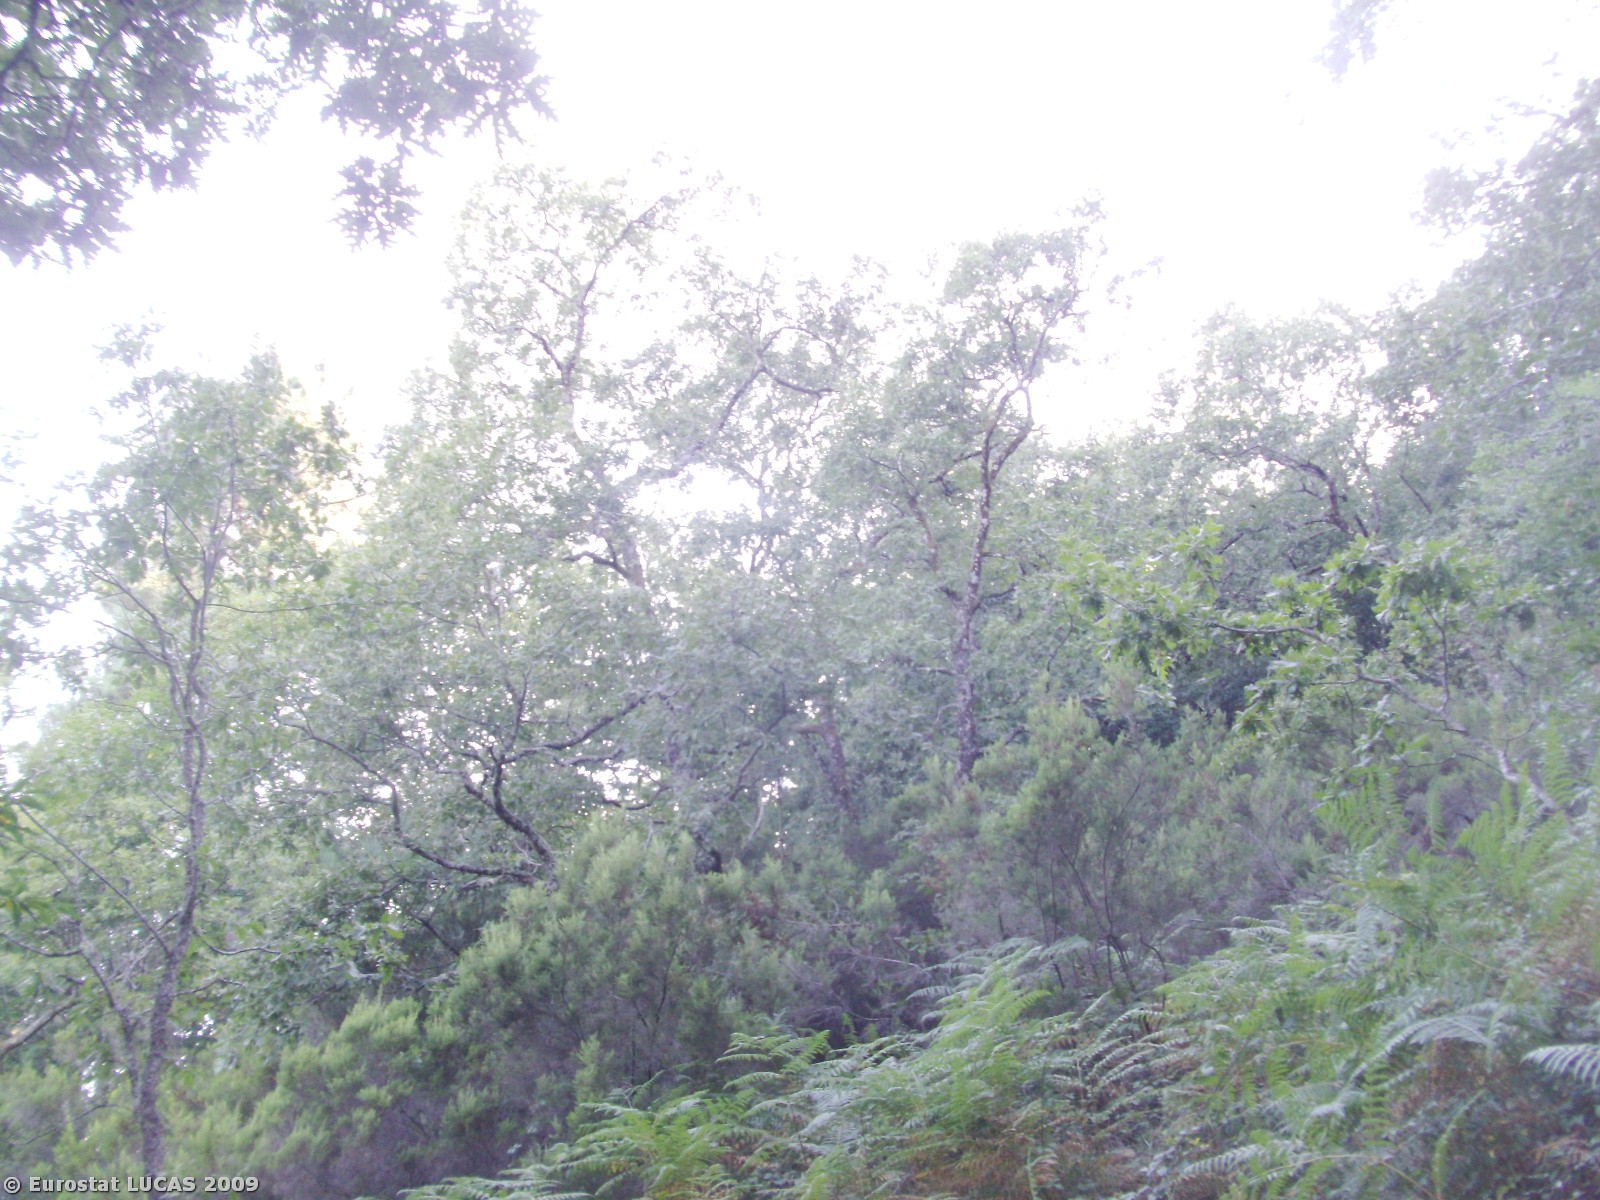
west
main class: Woodland
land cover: Mixed woodland
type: hemiboreal forest and nemoral coniferous forest and mixed broadleaved-coniferous forest
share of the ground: > 75 %
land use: Forestry
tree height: > 5 m
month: August
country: PT
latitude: 41.2944
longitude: -7.8428
